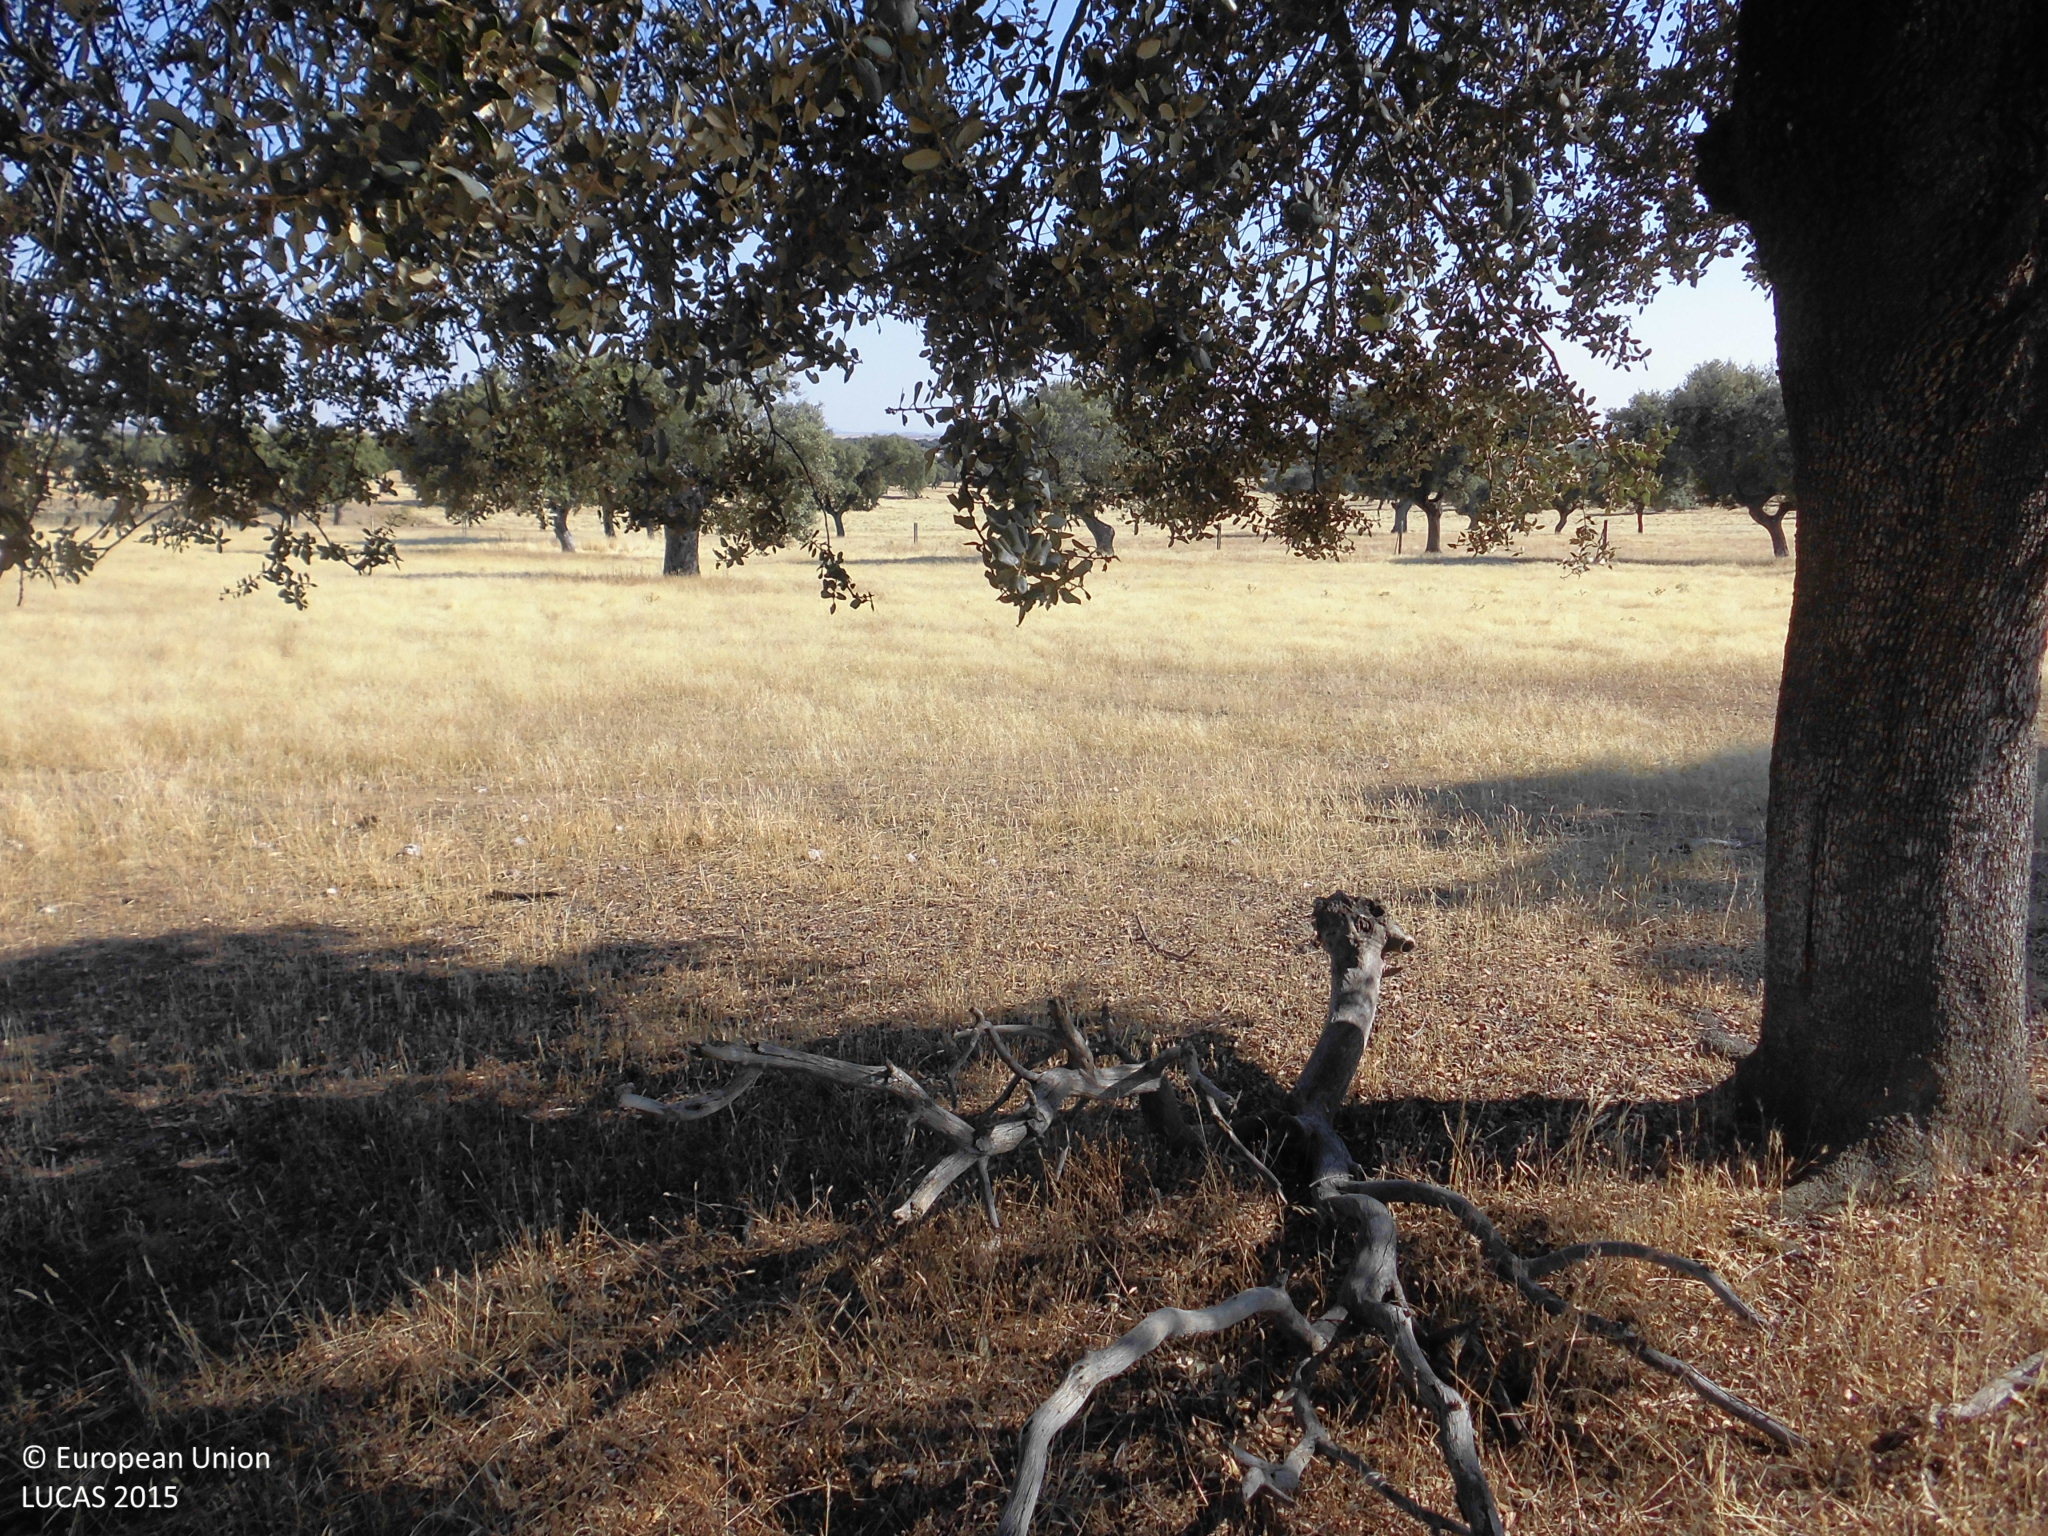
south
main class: Woodland
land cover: Broadleaved woodland
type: broadleaved evergreen forest
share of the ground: 10 - 25 %
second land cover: Grassland without tree/shrub cover
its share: > 75 %
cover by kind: herbaceous plants 85 %, broadleaved forest trees 15 %
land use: Forestry
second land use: Agriculture (excluding fallow land and kitchen gardens)
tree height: > 5 m
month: June
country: ES
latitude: 39.6451
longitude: -5.9932
